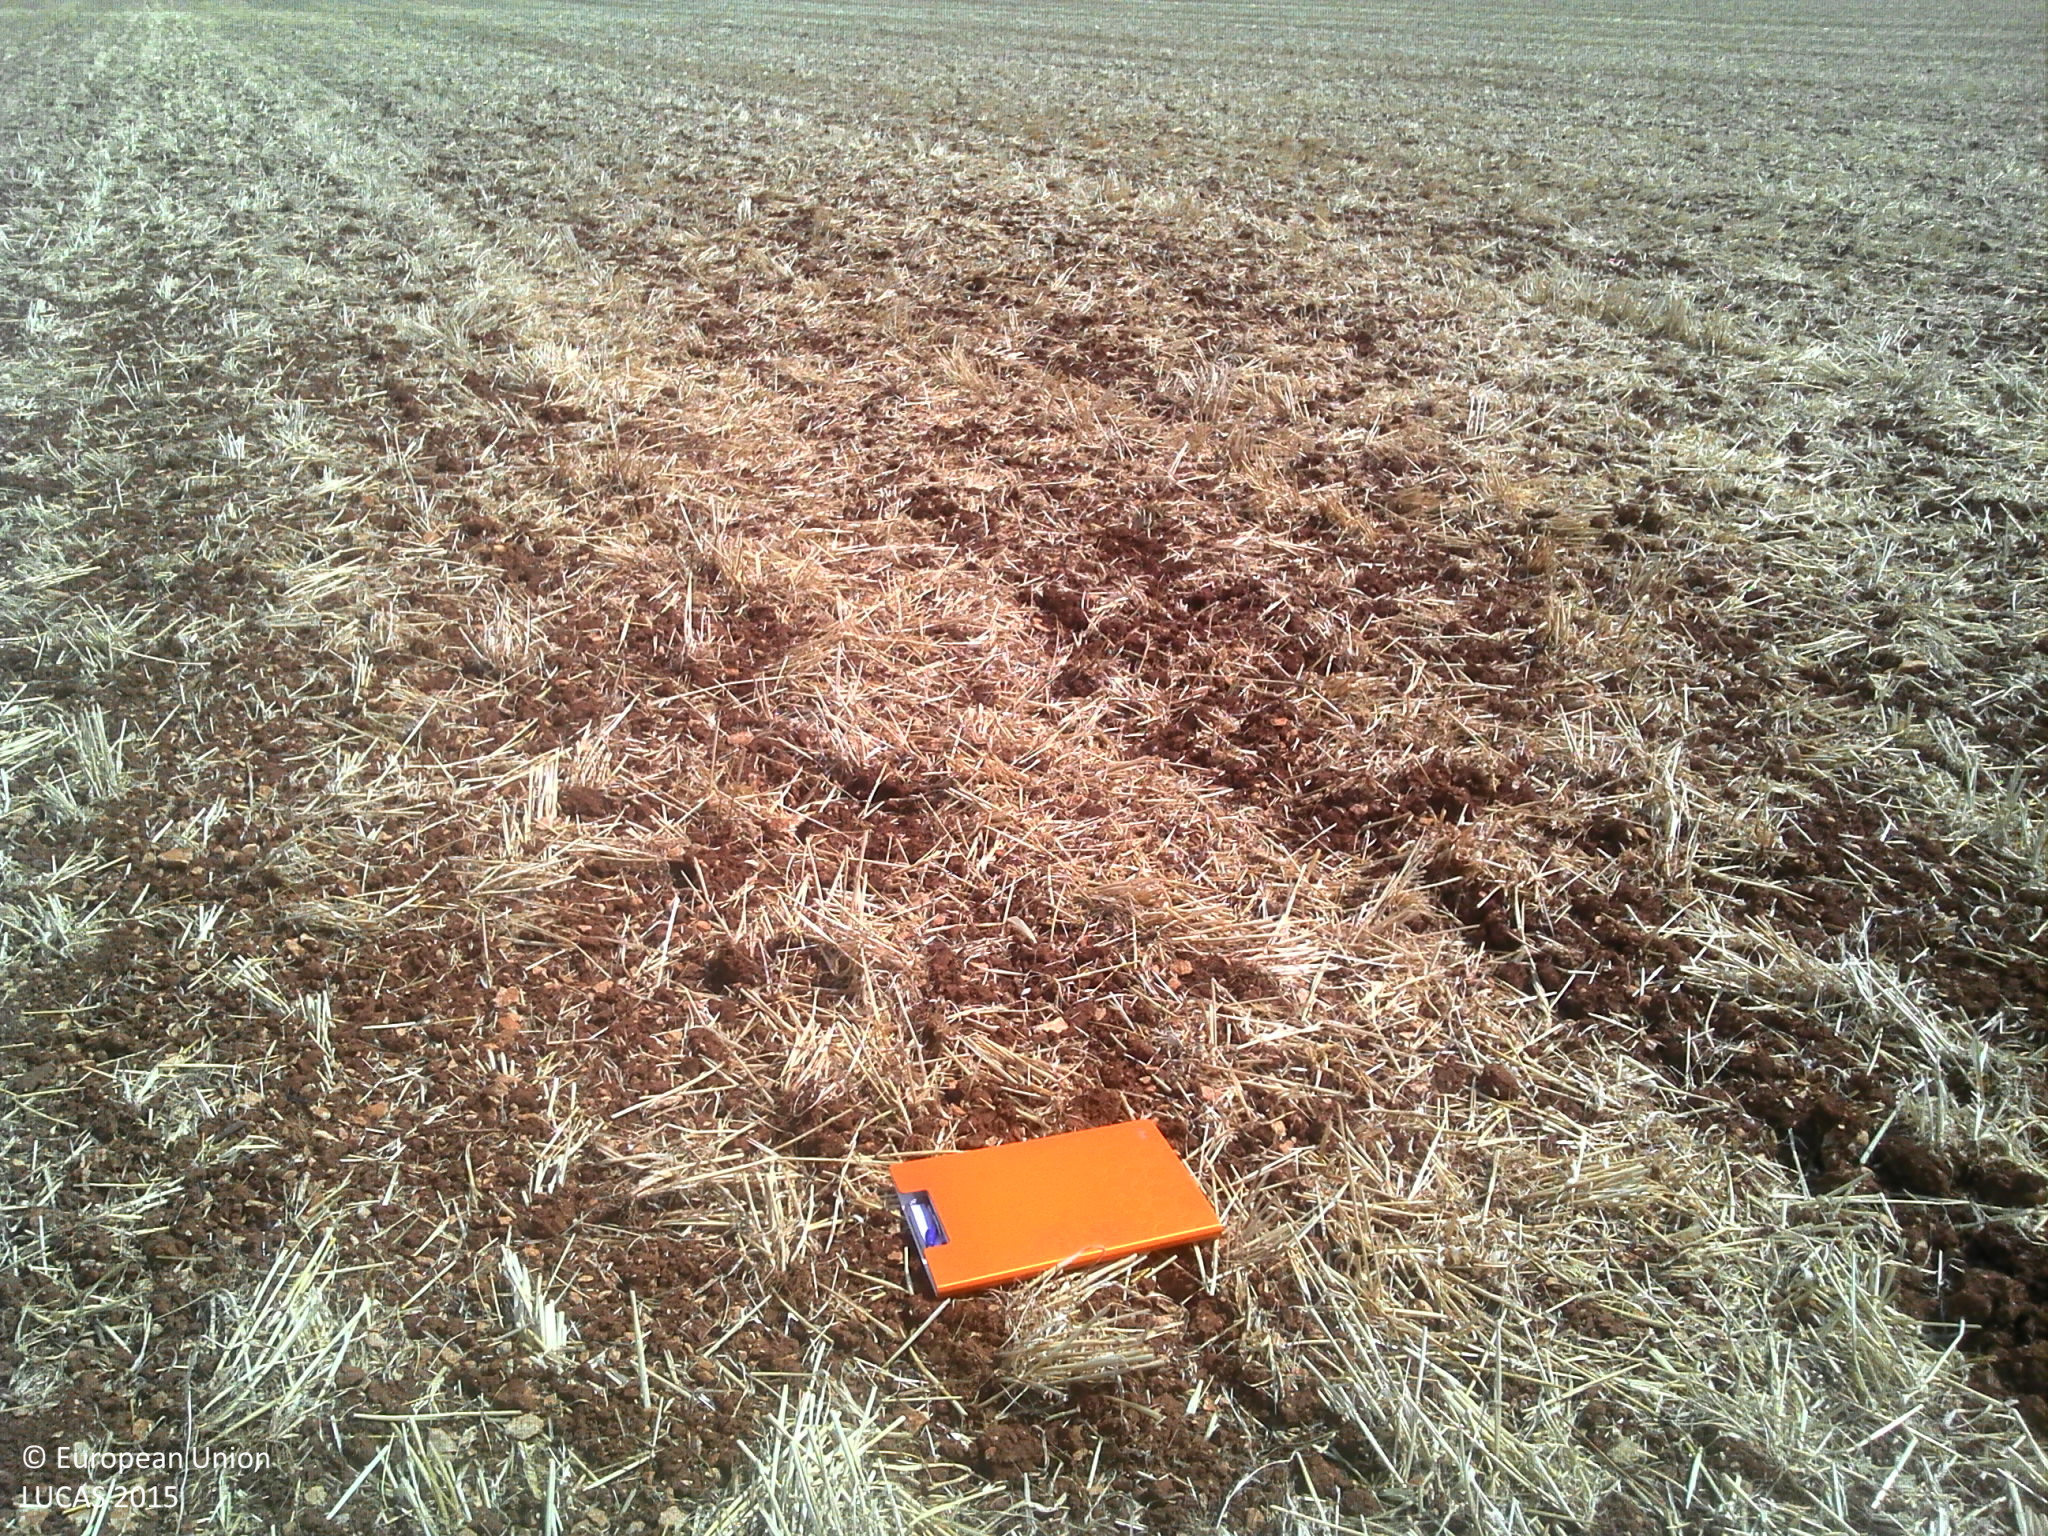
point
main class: Cropland
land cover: Common wheat
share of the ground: 10 - 25 %
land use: Agriculture (excluding fallow land and kitchen gardens)
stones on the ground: 10 - 25 %
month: September
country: FR
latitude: 47.9599
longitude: 4.8697
